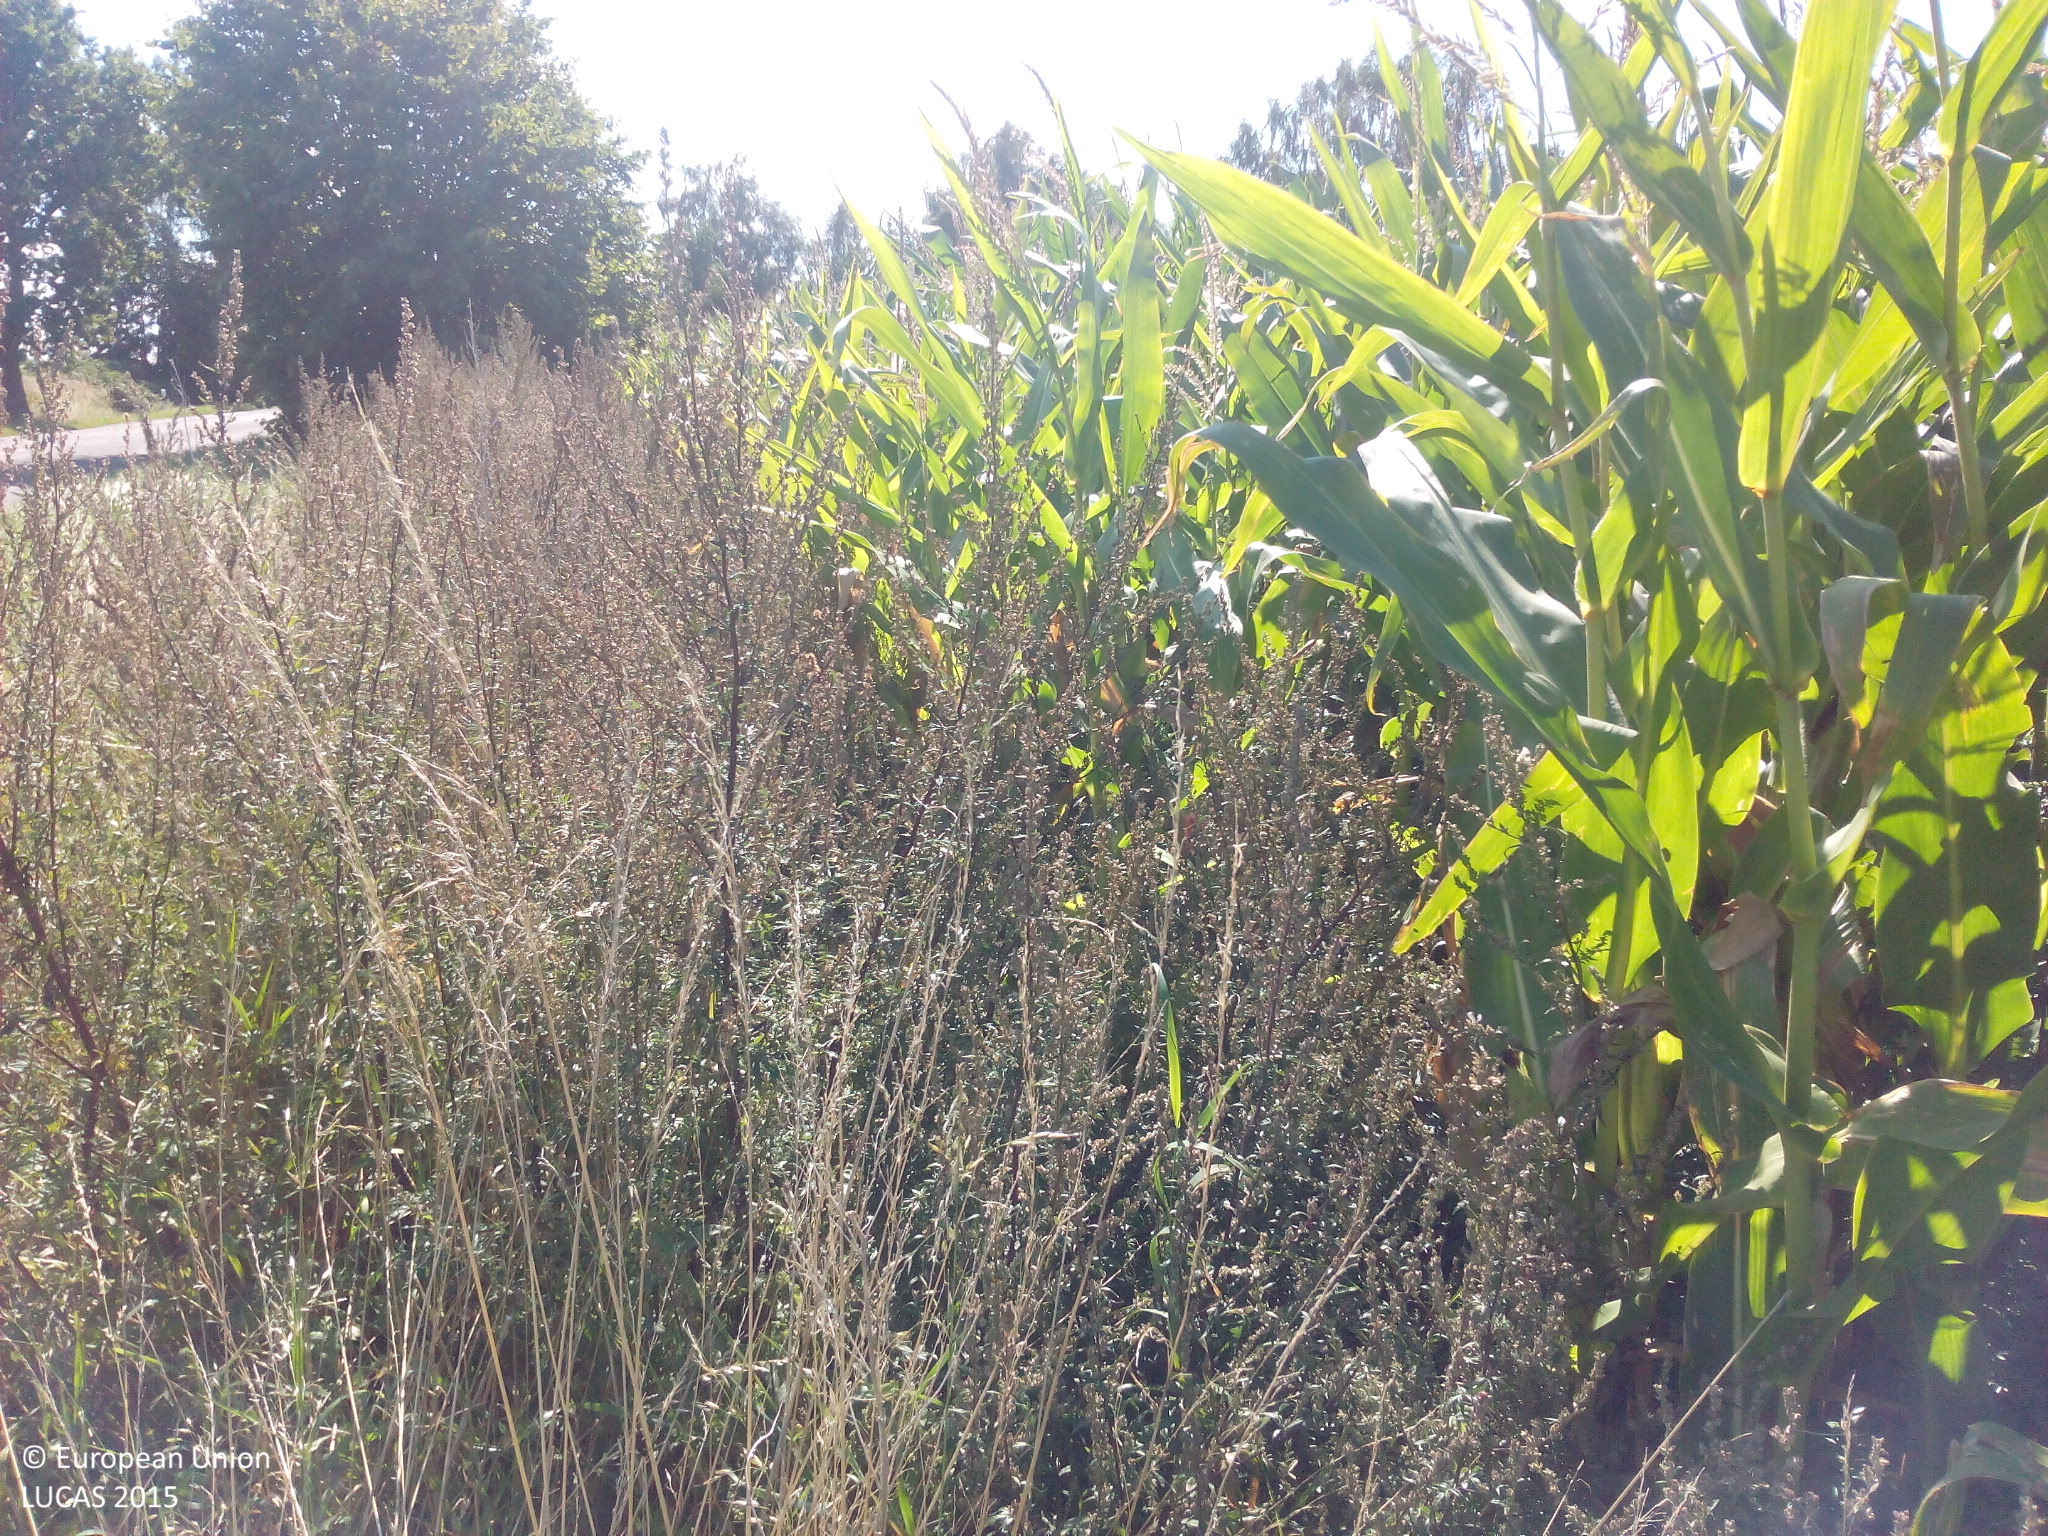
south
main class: Cropland
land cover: Maize
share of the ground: > 75 %
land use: Agriculture (excluding fallow land and kitchen gardens)
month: September
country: DE
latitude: 54.1525
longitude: 12.3417
